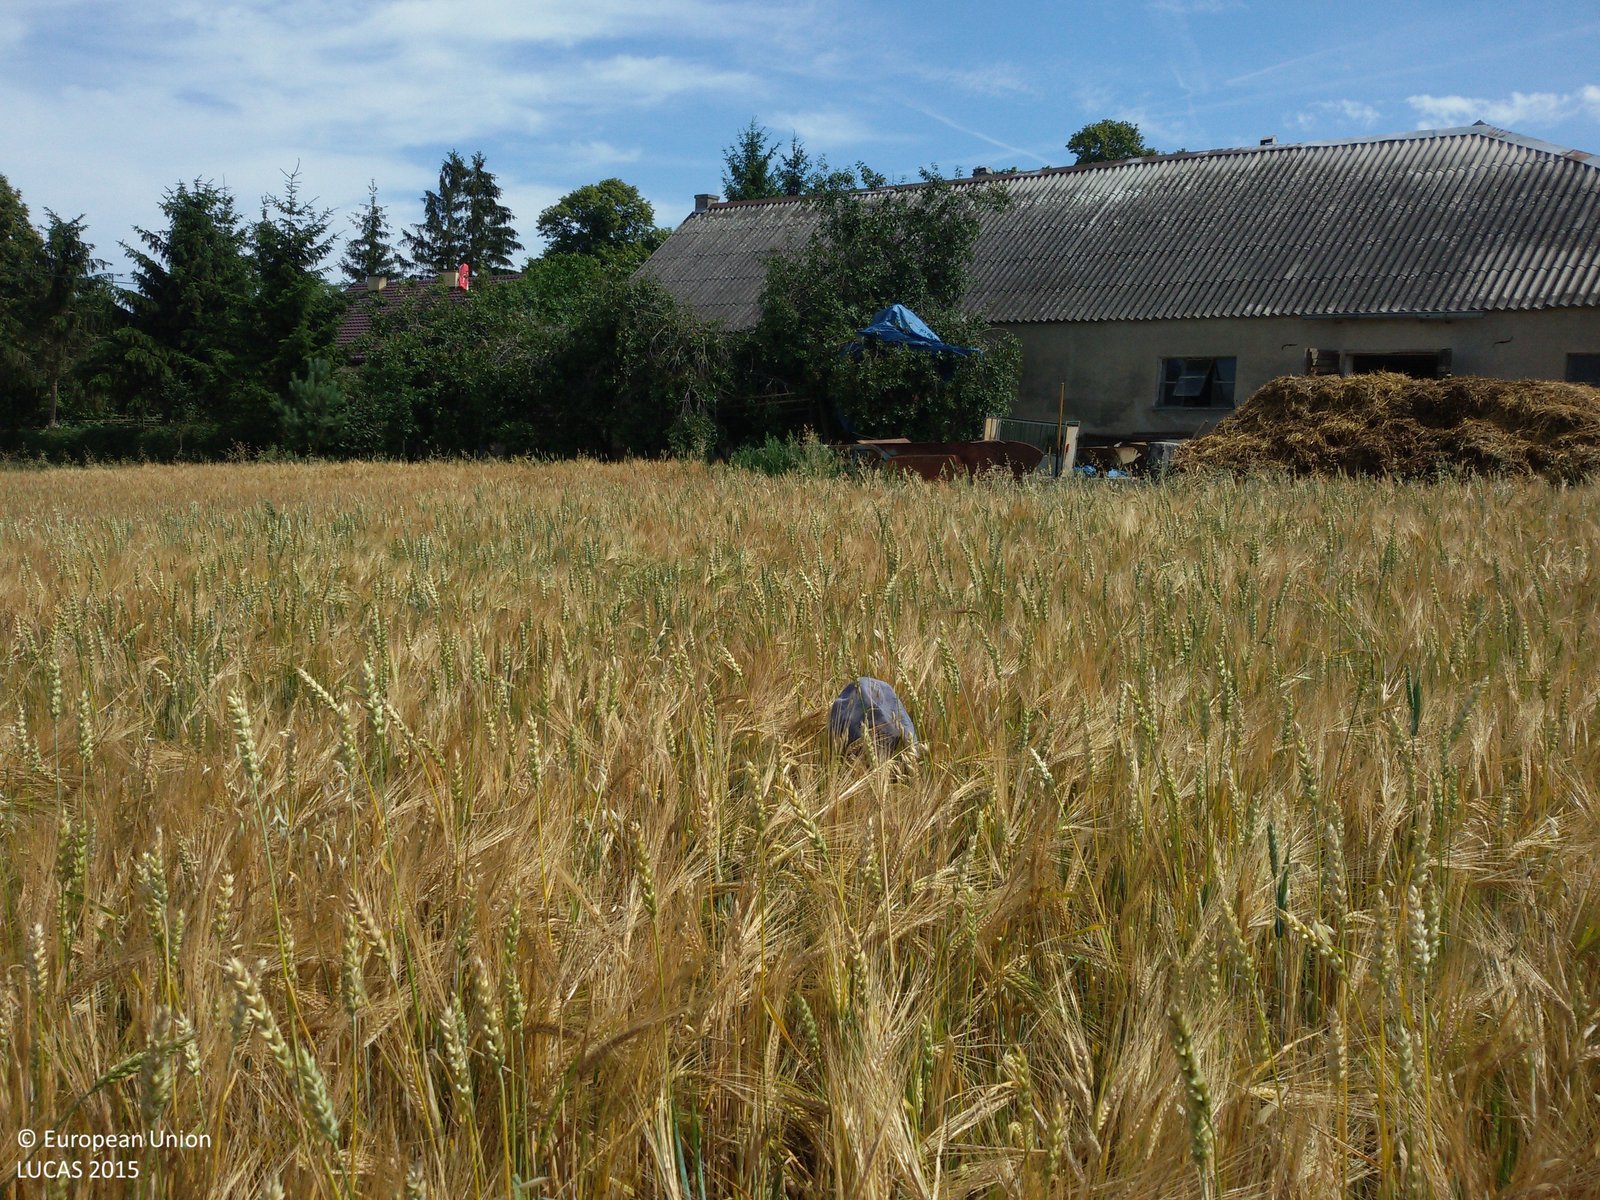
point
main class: Cropland
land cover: Barley
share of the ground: 50 - 75 %
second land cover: Common wheat
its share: 50 - 75 %
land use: Agriculture (excluding fallow land and kitchen gardens)
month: July
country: PL
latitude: 53.4433
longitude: 17.7366
